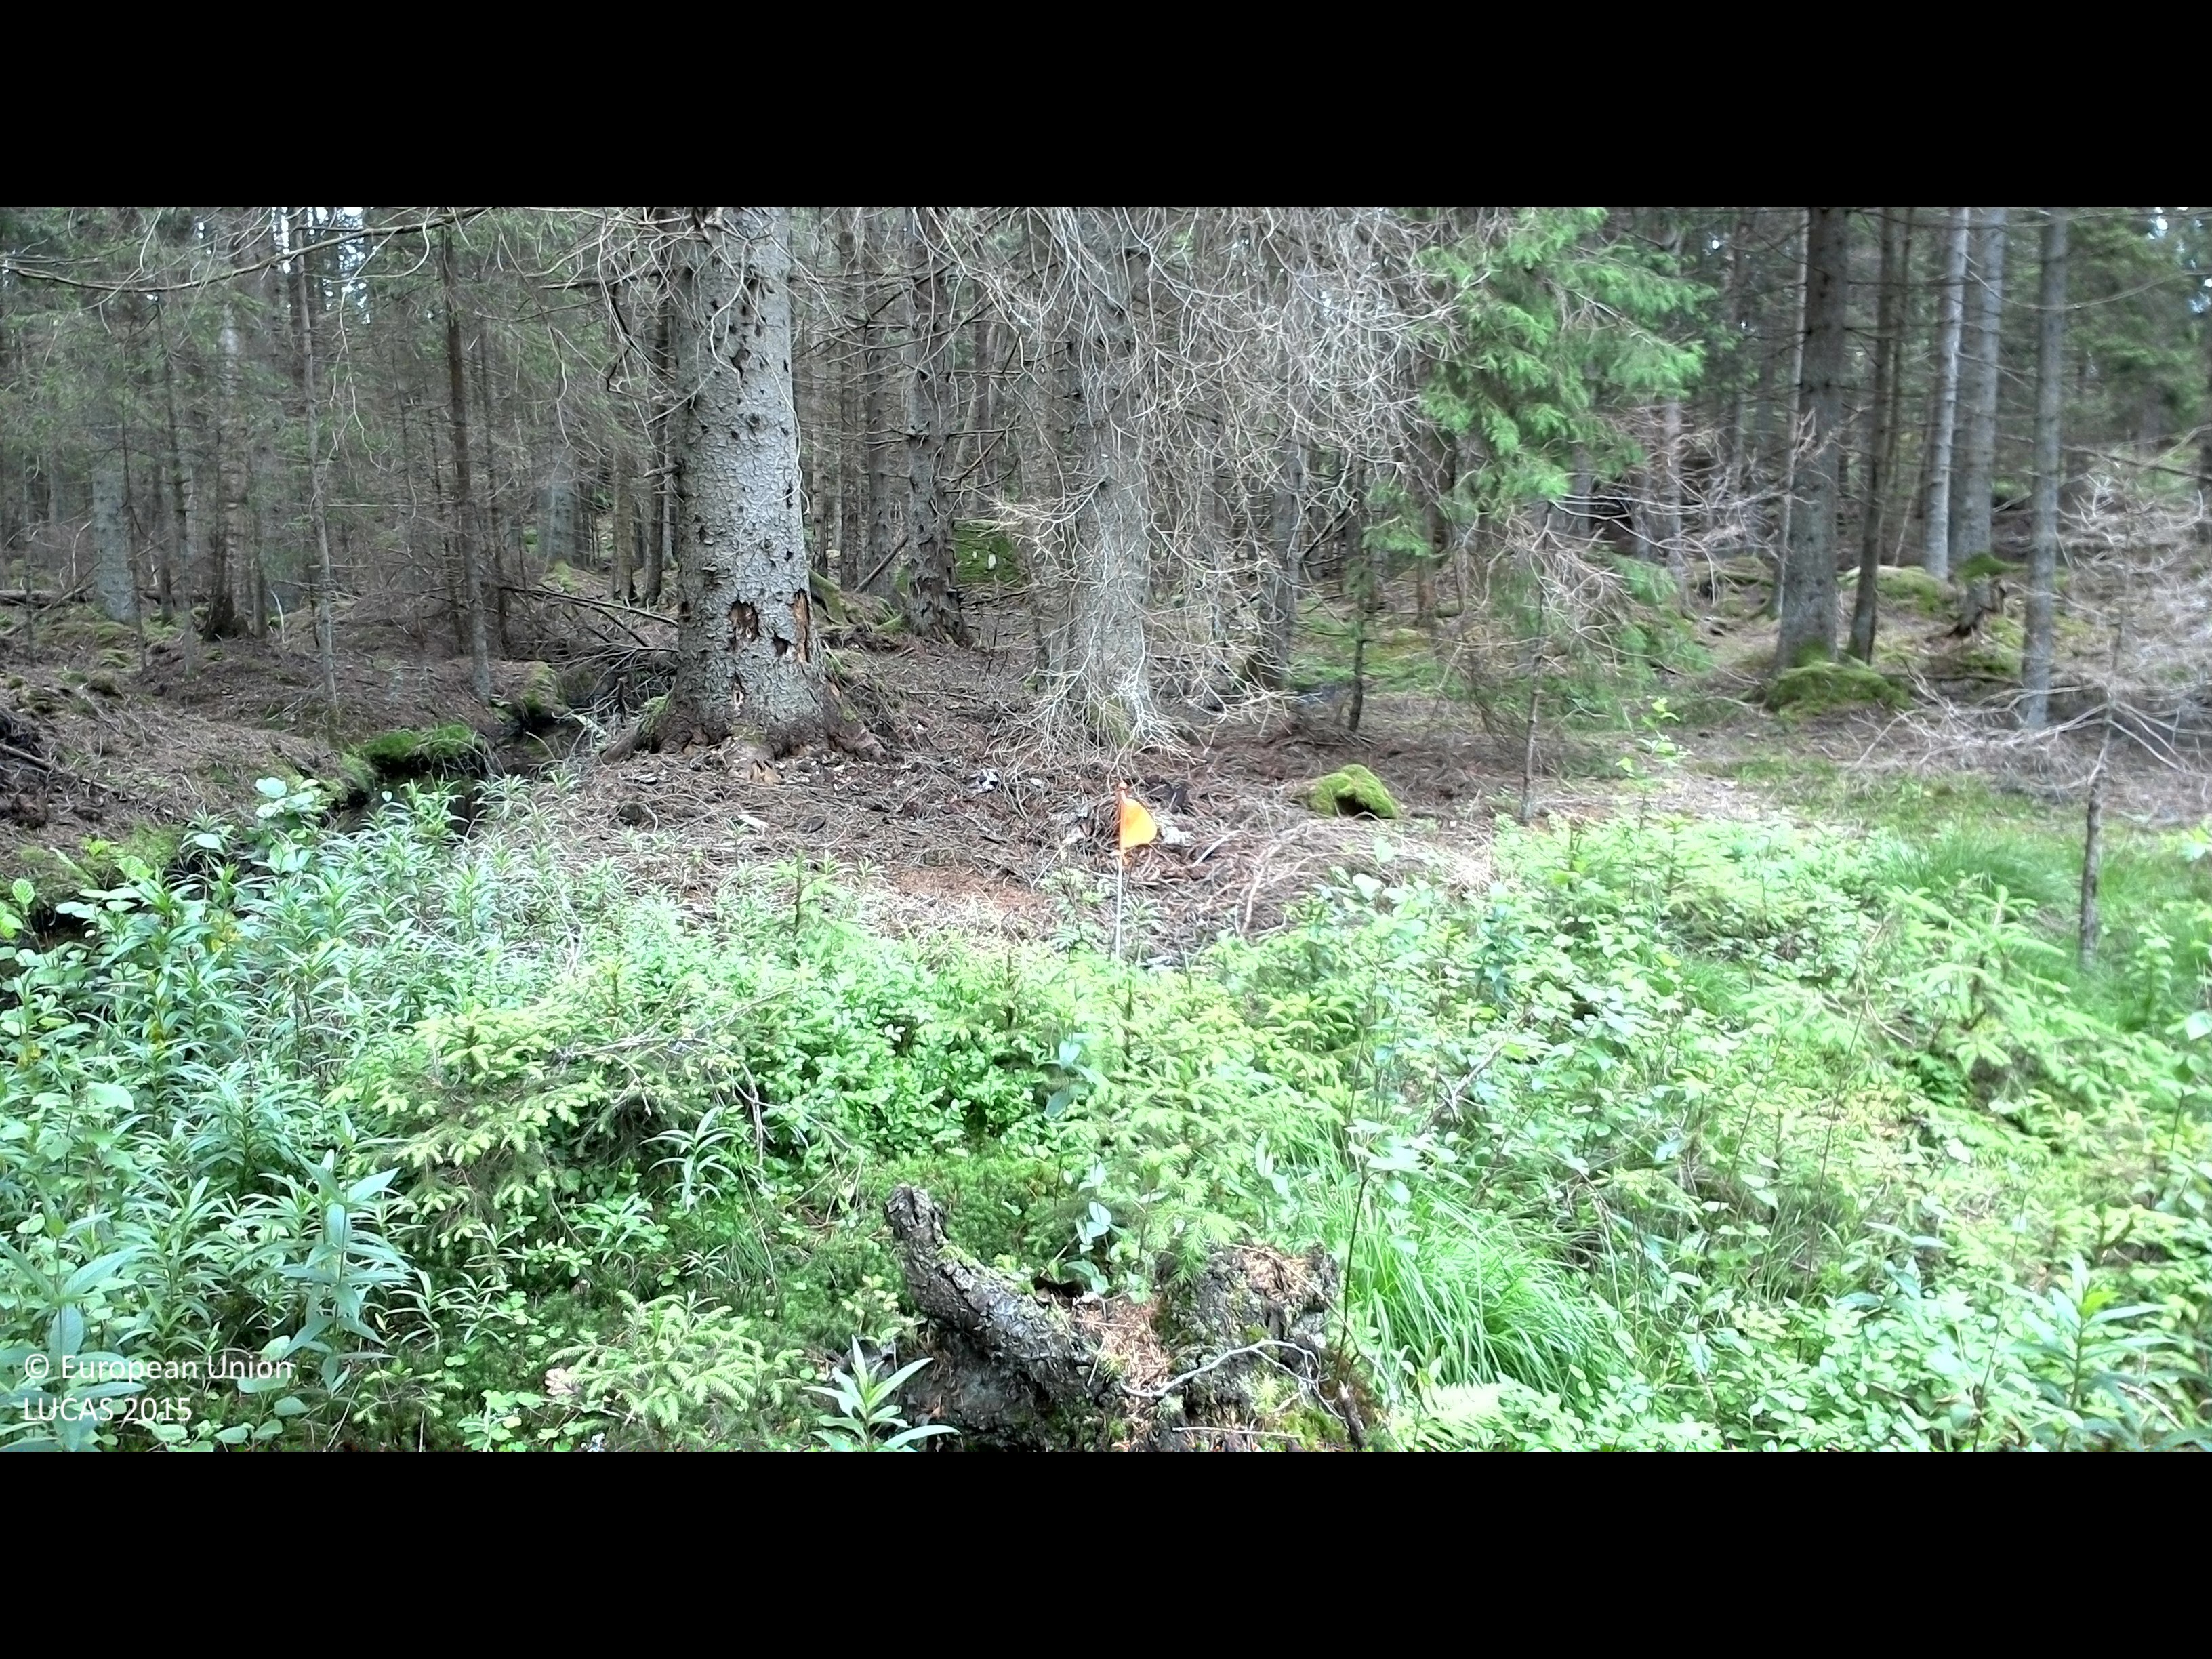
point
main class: Woodland
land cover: Spruce dominated coniferous woodland
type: boreal forest
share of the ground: 50 - 75 %
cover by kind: coniferous forest trees 65 %, herbaceous plants 15 %, lichens and mosses 15 %, broadleaved forest trees 5 %
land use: Forestry
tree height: > 5 m
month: June
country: SE
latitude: 56.5388
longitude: 15.9030
